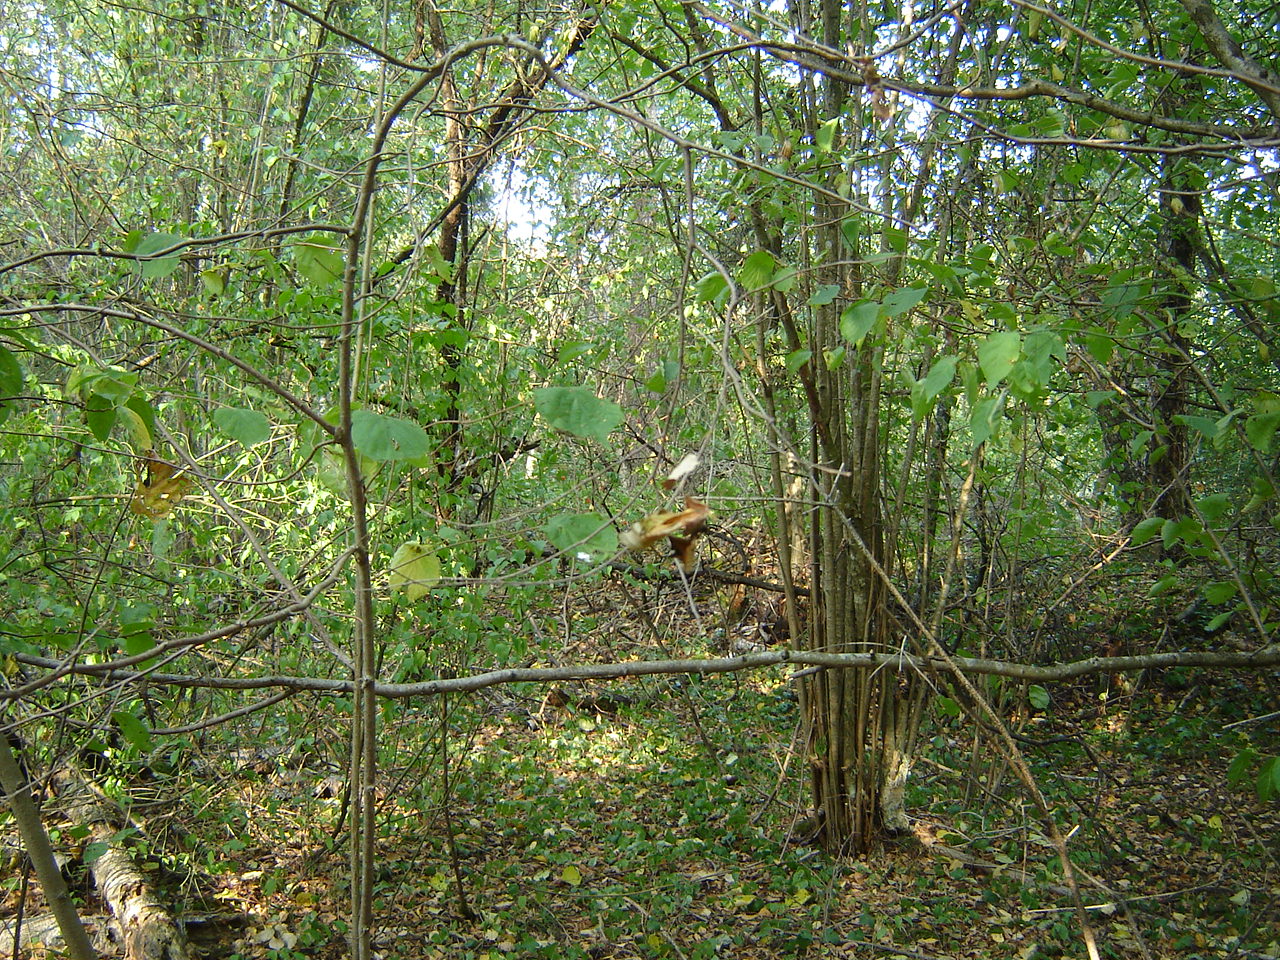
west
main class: Woodland
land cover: Spruce dominated mixed woodland
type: hemiboreal forest and nemoral coniferous forest and mixed broadleaved-coniferous forest
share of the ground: > 75 %
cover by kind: broadleaved forest trees 55 %, coniferous forest trees 30 %, unconsolidated bare surface 10 %, herbaceous plants 5 %
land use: Forestry
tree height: > 5 m
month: September
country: LT
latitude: 54.5037
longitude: 25.2075
